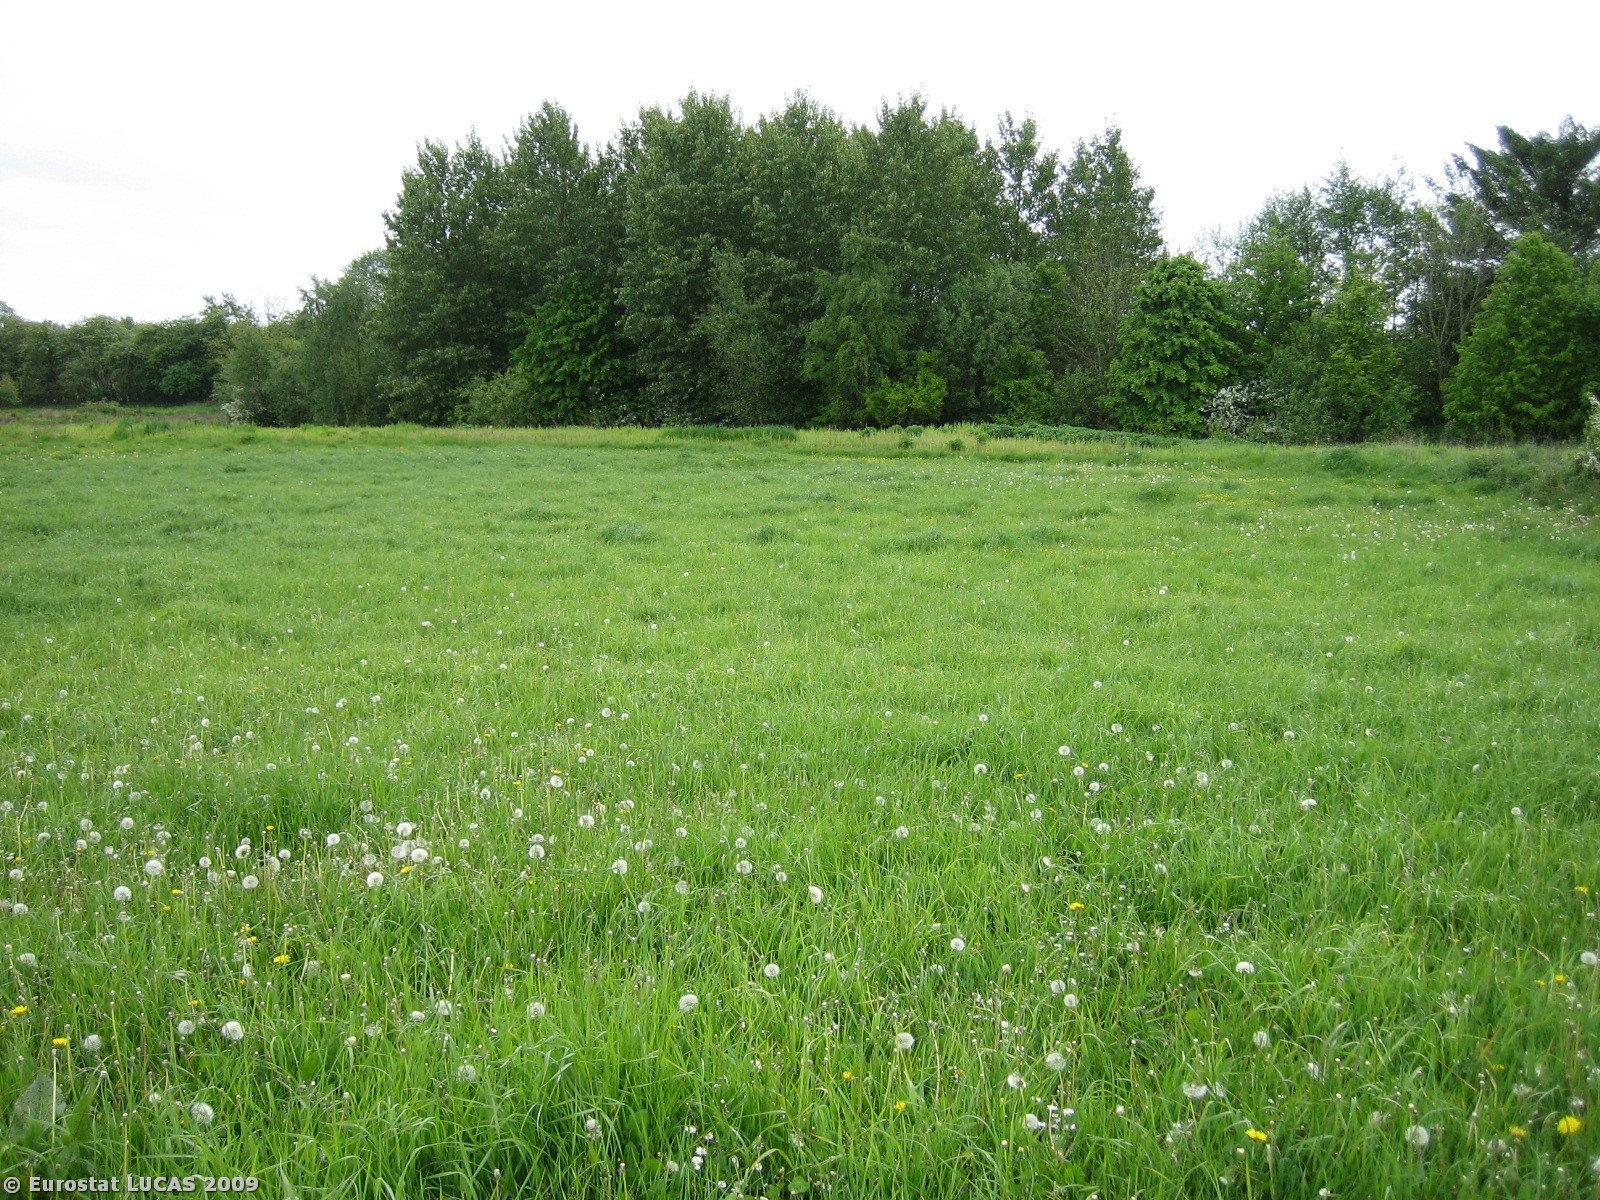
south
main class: Grassland
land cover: Grassland without tree/shrub cover
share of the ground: > 75 %
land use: Agriculture (excluding fallow land and kitchen gardens)
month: May
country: DK
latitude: 56.2186
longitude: 8.8564
